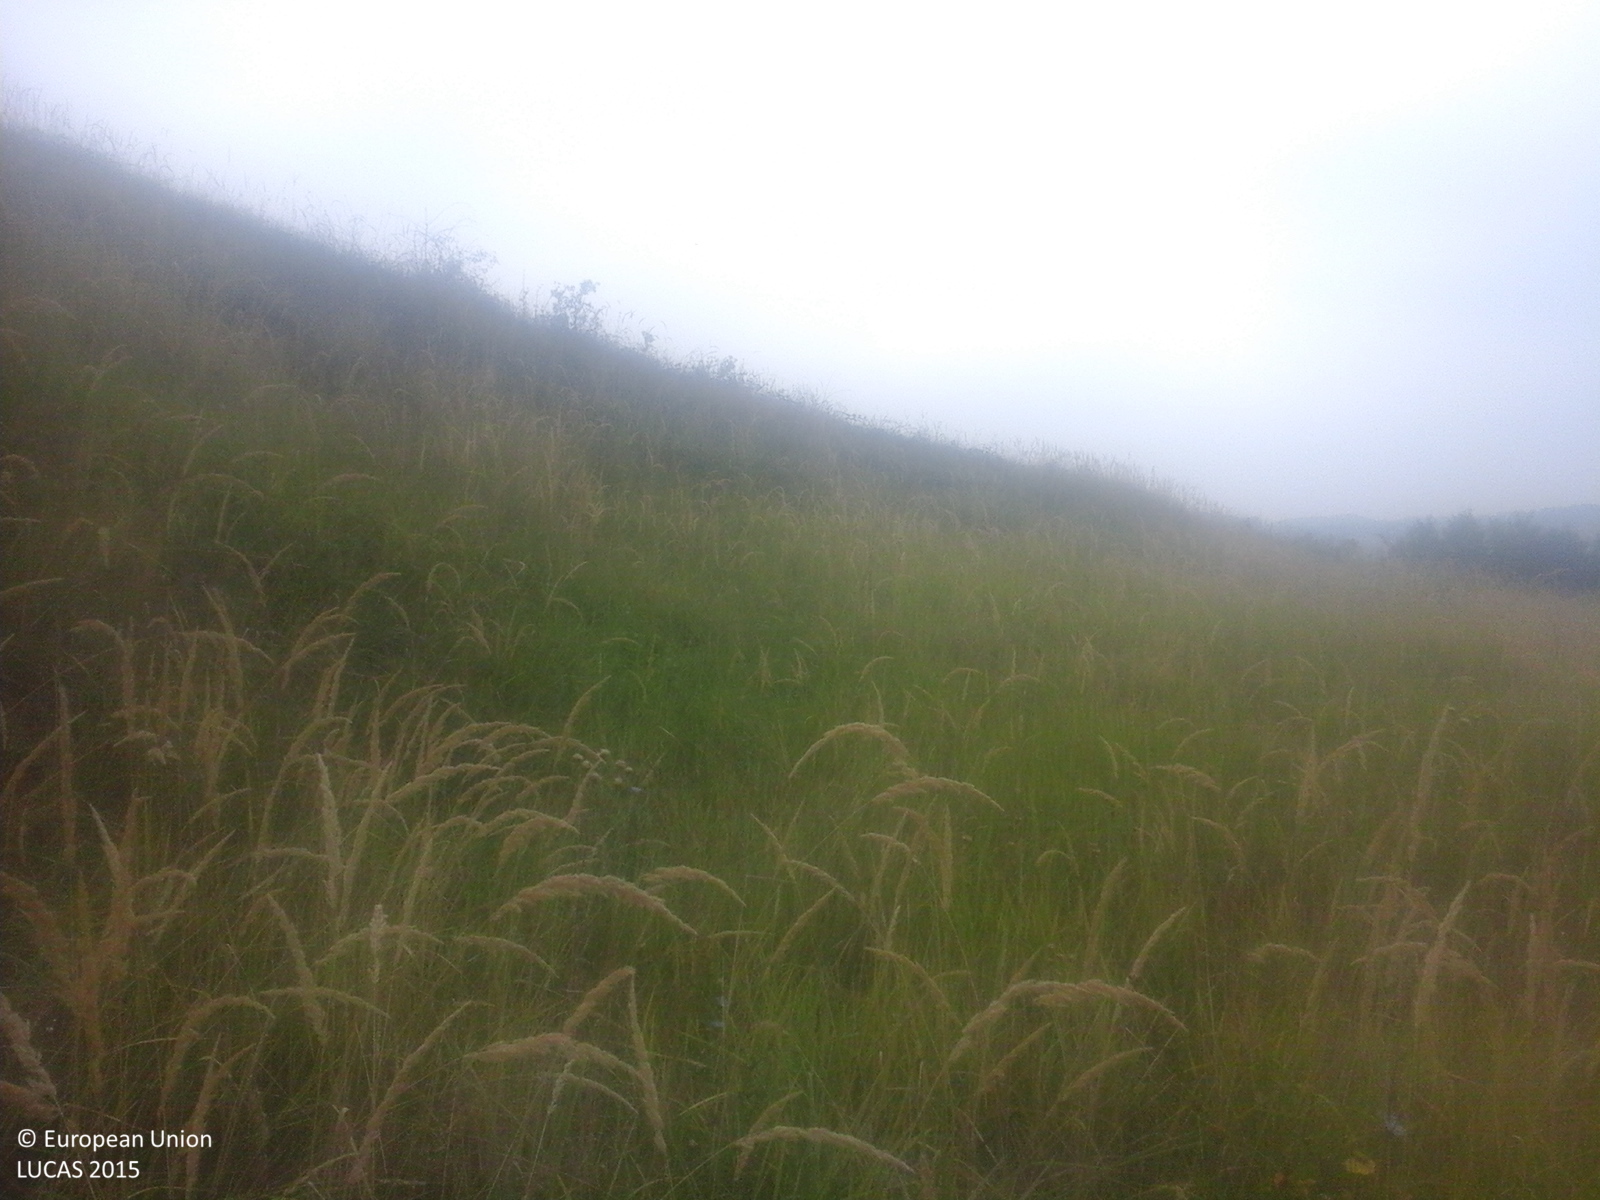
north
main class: Grassland
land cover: Spontaneously vegetated surfaces
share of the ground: > 75 %
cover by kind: herbaceous plants 100 %
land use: Fallow land
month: September
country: RO
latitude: 44.7446
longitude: 23.1981
